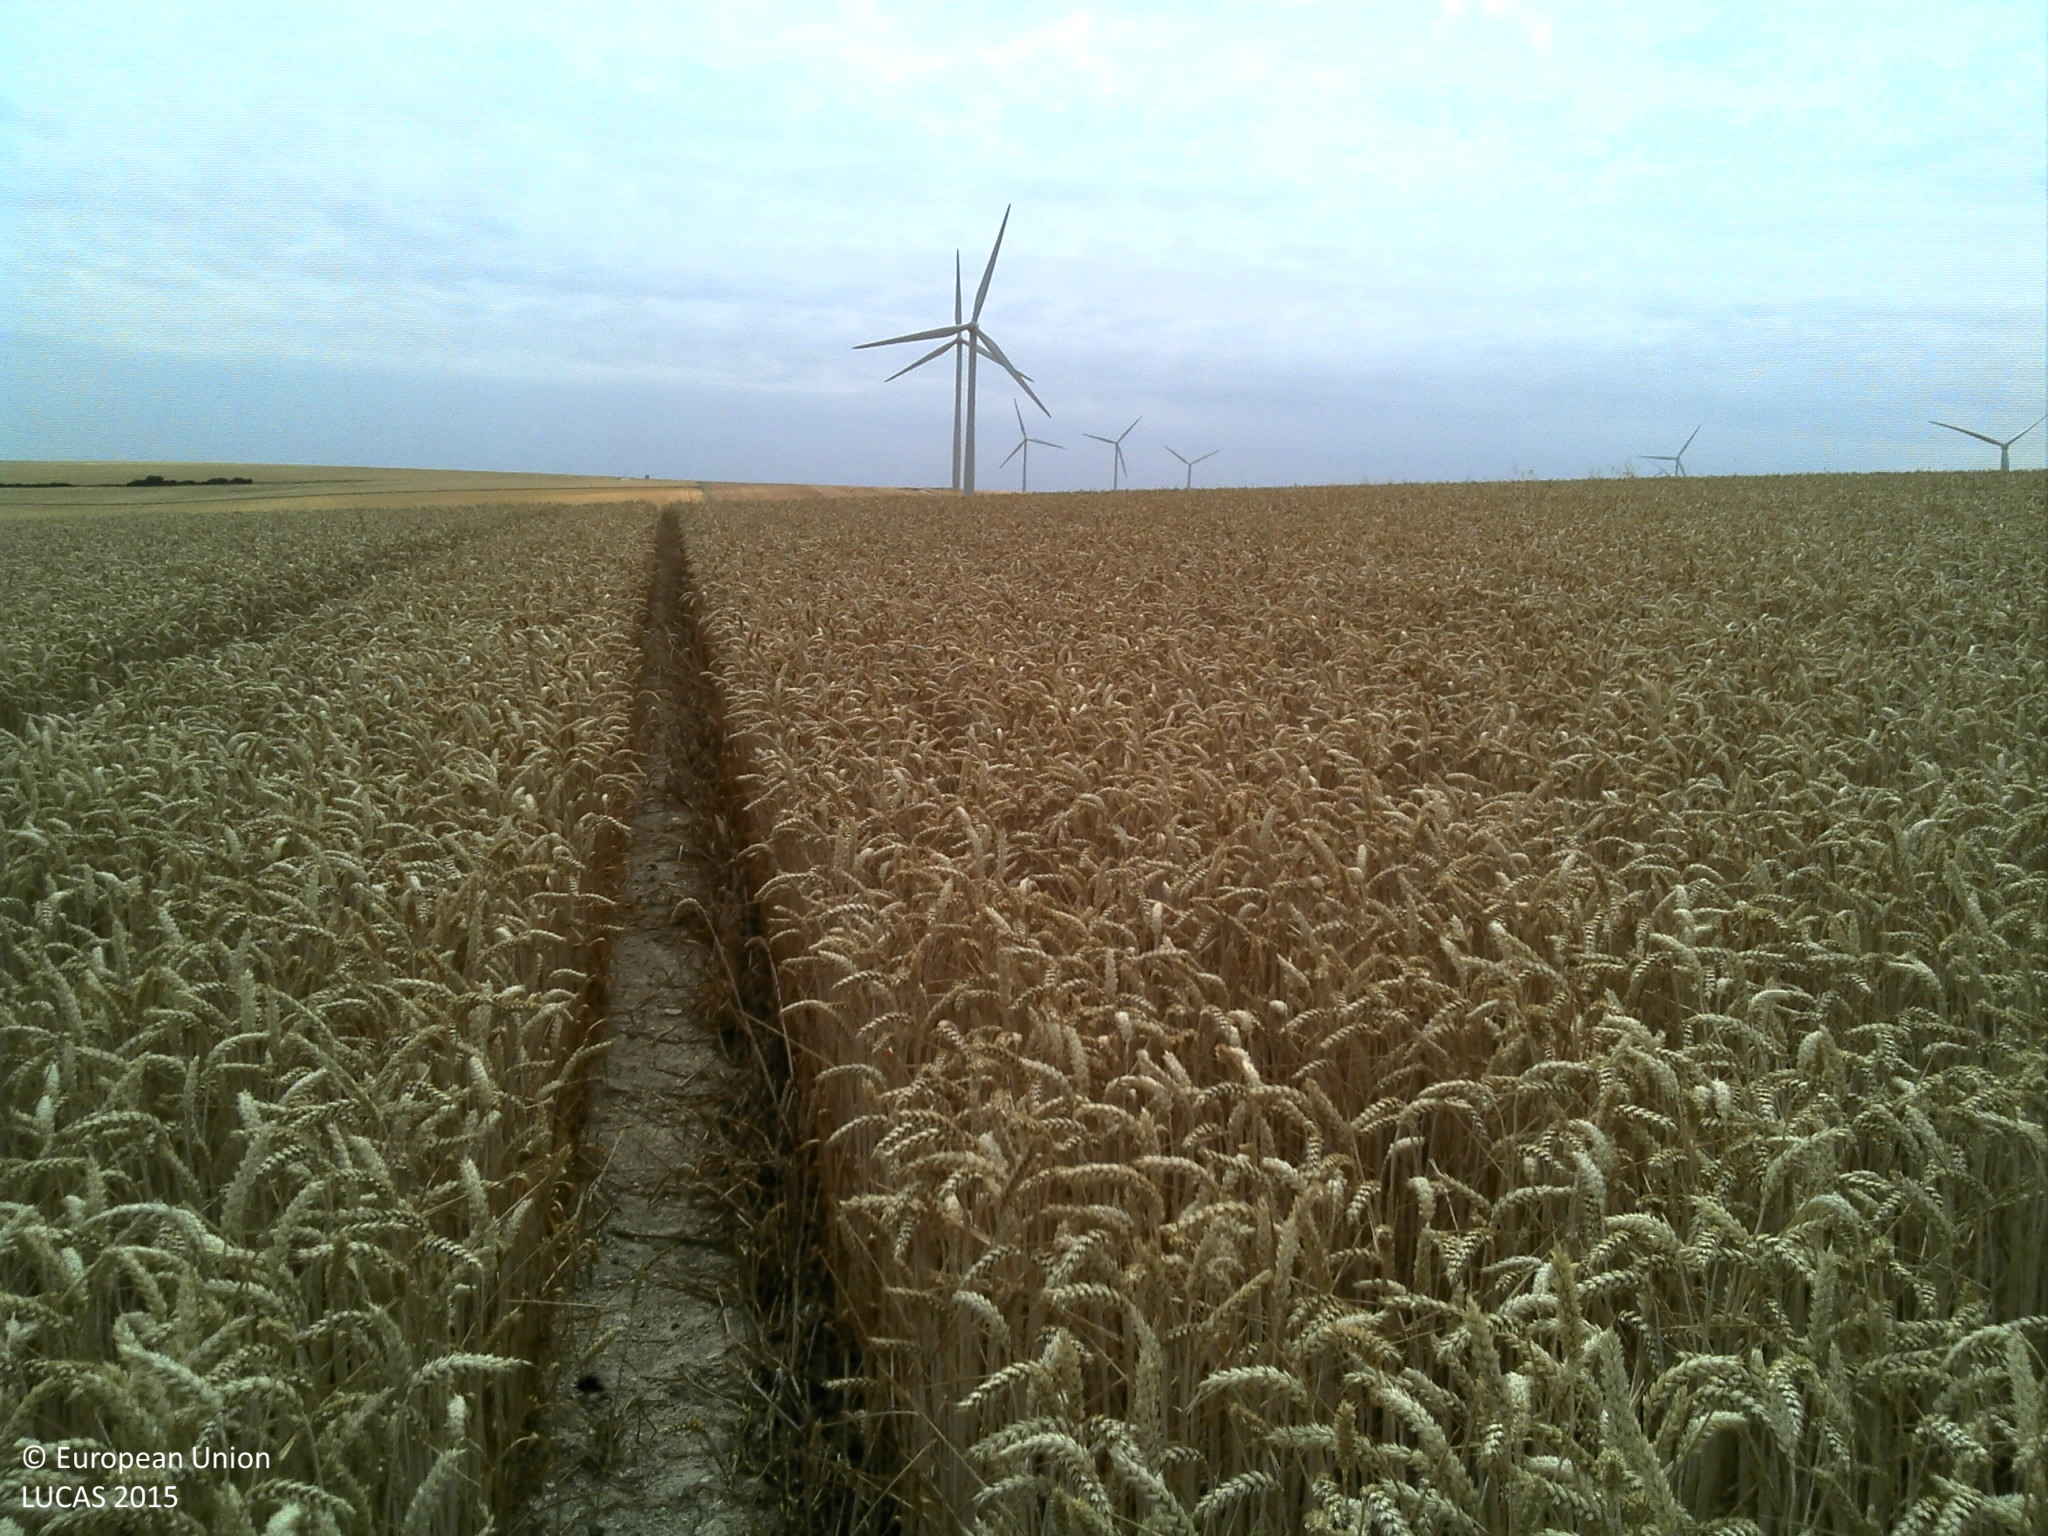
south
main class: Cropland
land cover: Common wheat
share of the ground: > 75 %
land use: Agriculture (excluding fallow land and kitchen gardens)
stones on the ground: < 10 %
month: July
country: FR
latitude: 48.8108
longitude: 4.5637
